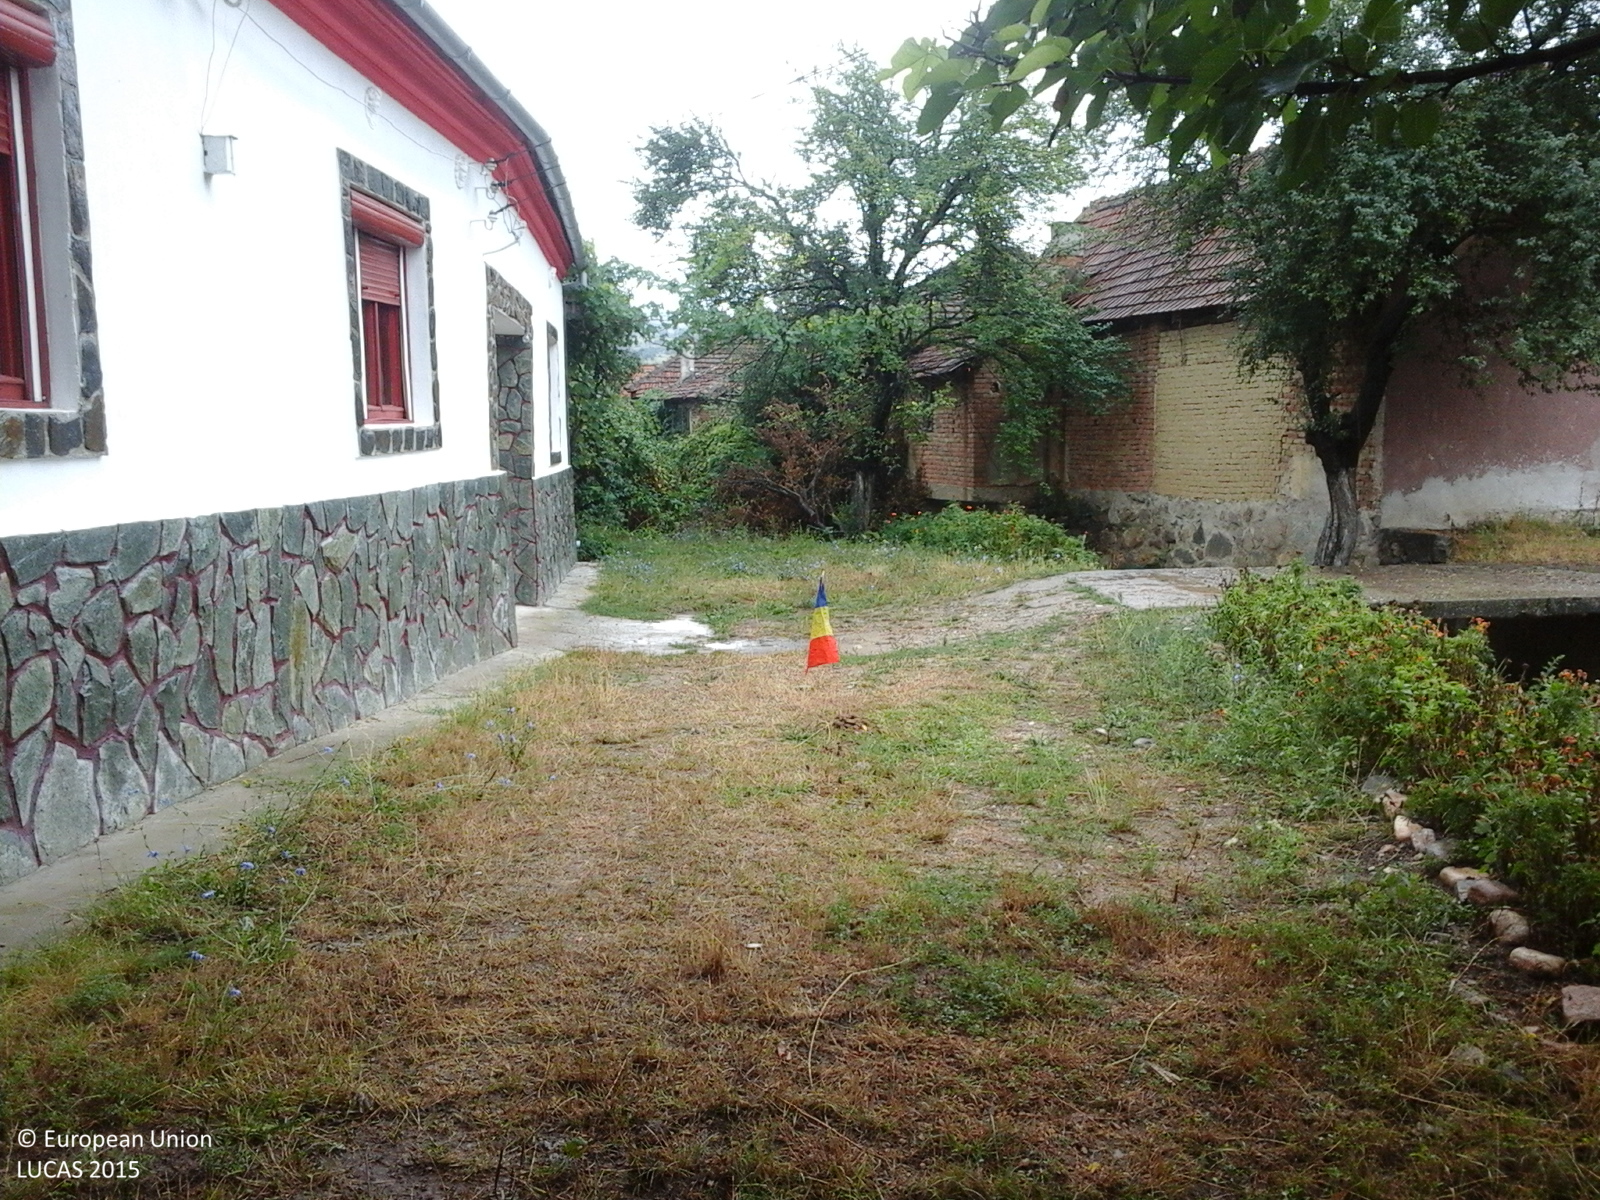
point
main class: Grassland
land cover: Grassland without tree/shrub cover
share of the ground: > 75 %
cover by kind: herbaceous plants 100 %
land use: Residential
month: August
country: RO
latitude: 45.0414
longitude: 22.2643
